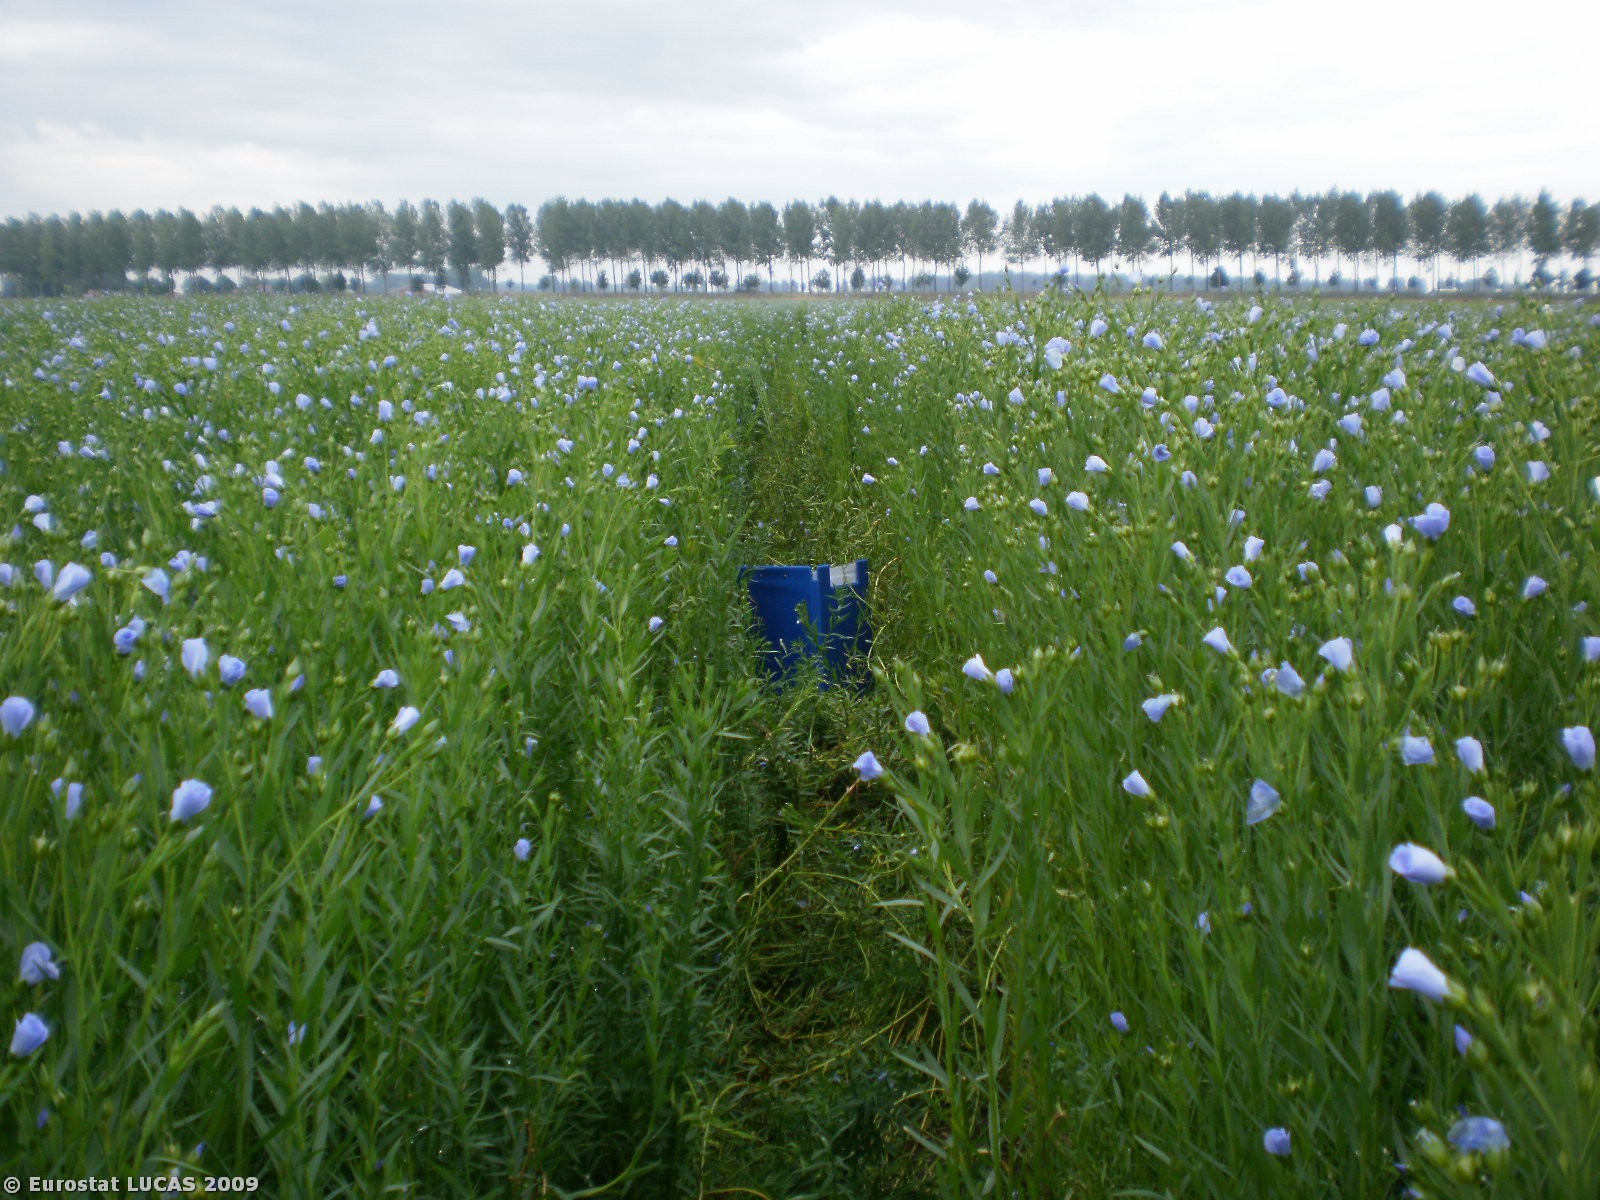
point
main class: Cropland
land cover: Other fibre and oleaginous crops
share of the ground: > 75 %
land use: Agriculture (excluding fallow land and kitchen gardens)
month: June
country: BE
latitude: 51.2591
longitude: 4.1337
